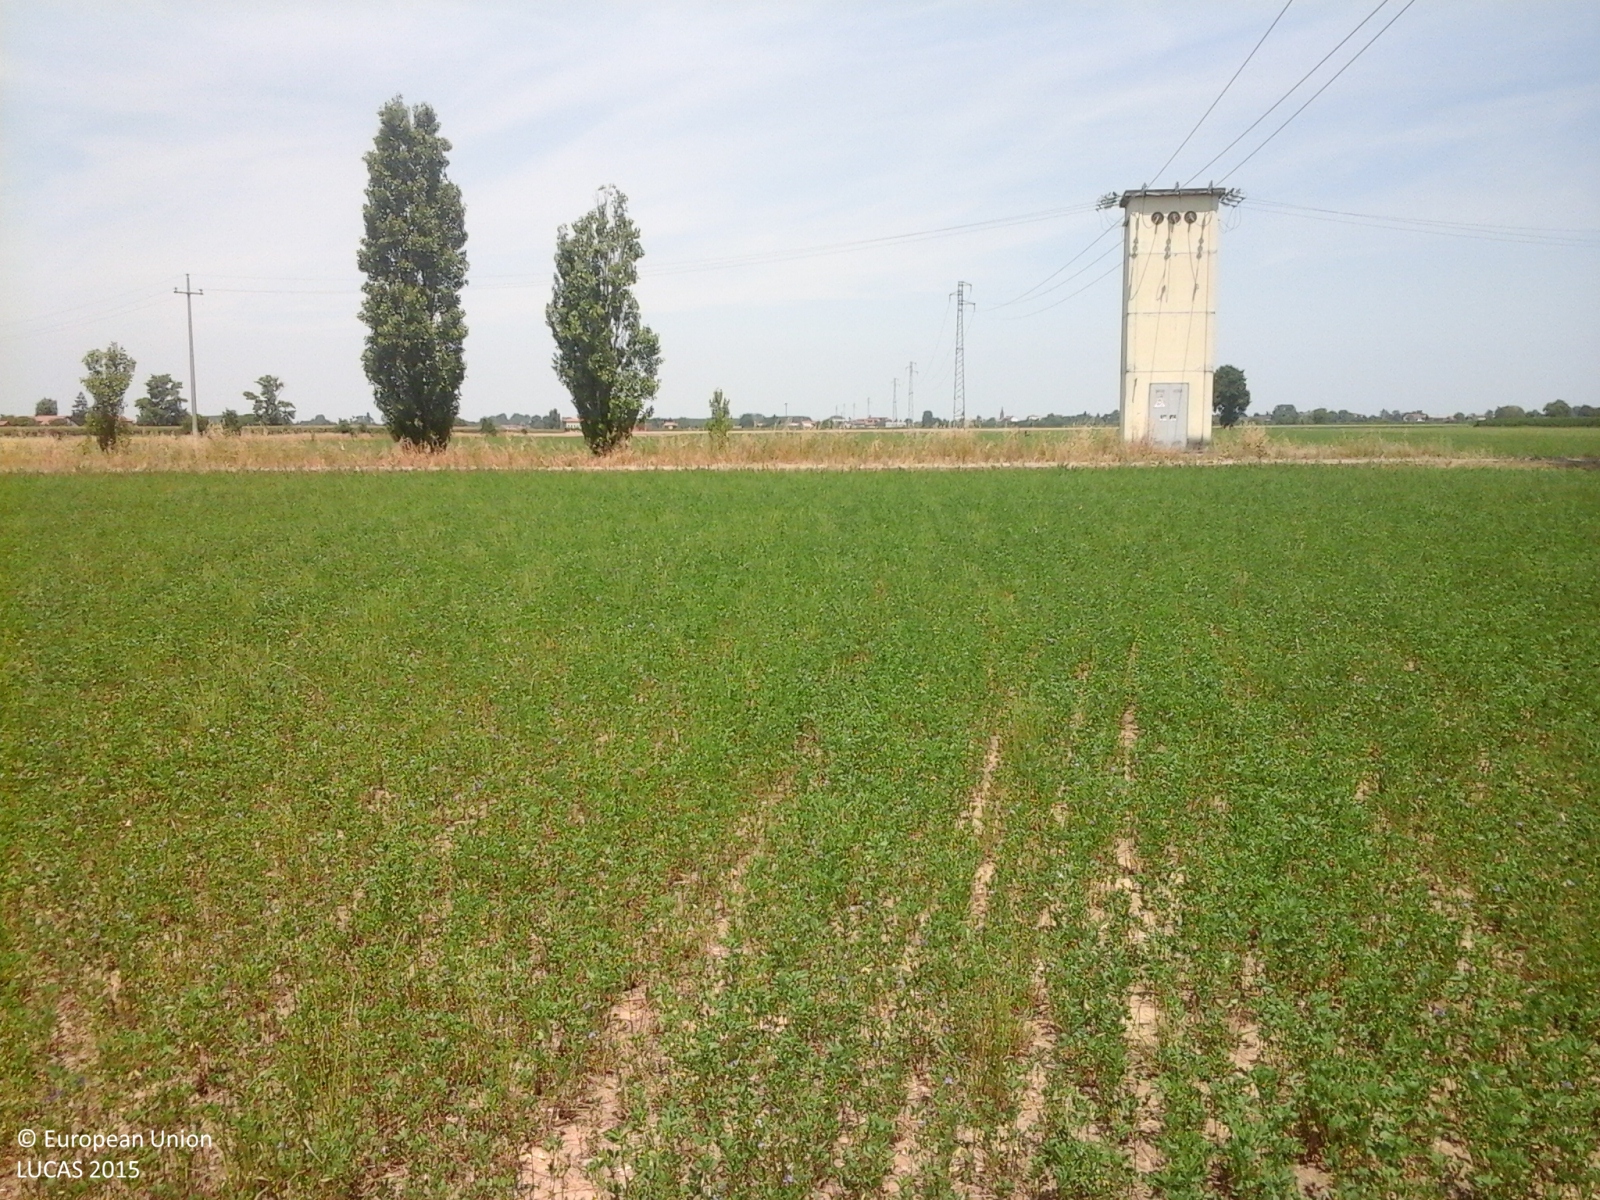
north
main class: Cropland
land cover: Lucerne
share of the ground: > 75 %
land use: Agriculture (excluding fallow land and kitchen gardens)
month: June
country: IT
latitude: 44.9568
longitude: 8.7981
